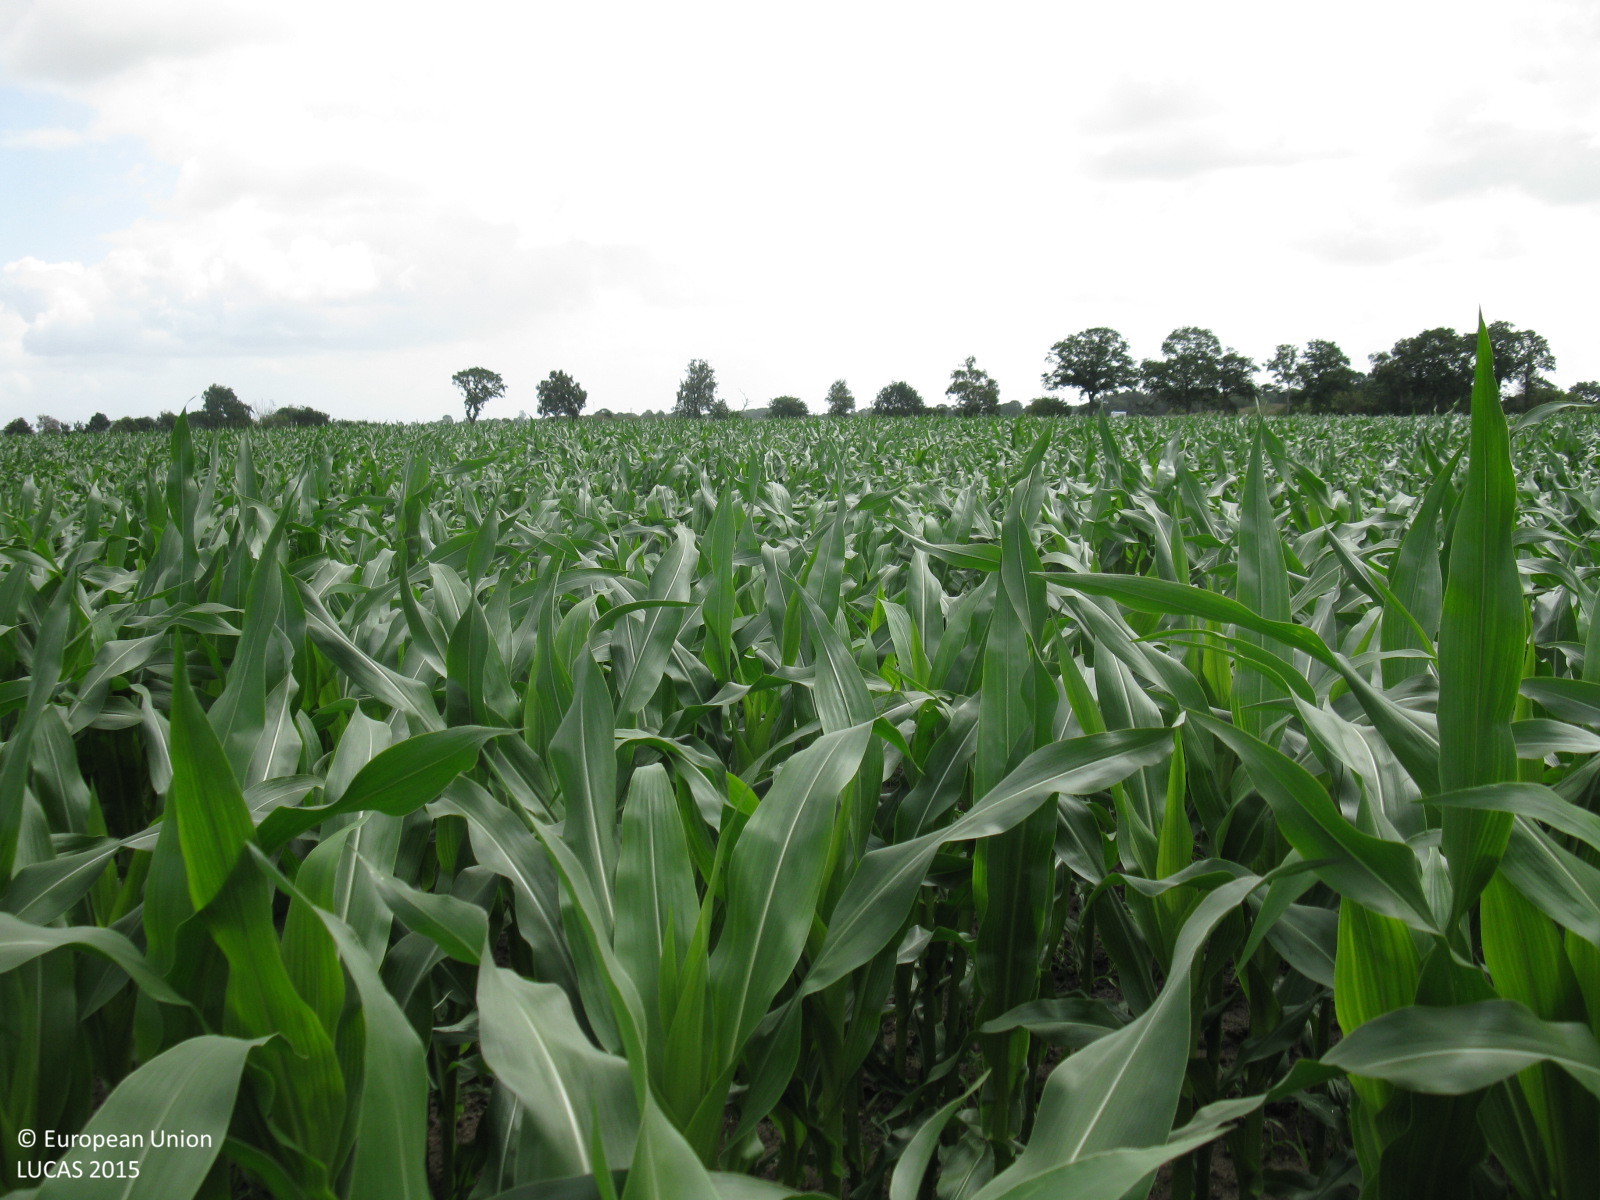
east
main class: Cropland
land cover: Maize
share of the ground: > 75 %
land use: Agriculture (excluding fallow land and kitchen gardens)
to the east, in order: Maize; Grass margins; Paved roads, cycling and walking lanes; Grass margins; Maize
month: July
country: DE
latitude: 53.4558
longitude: 7.9074
